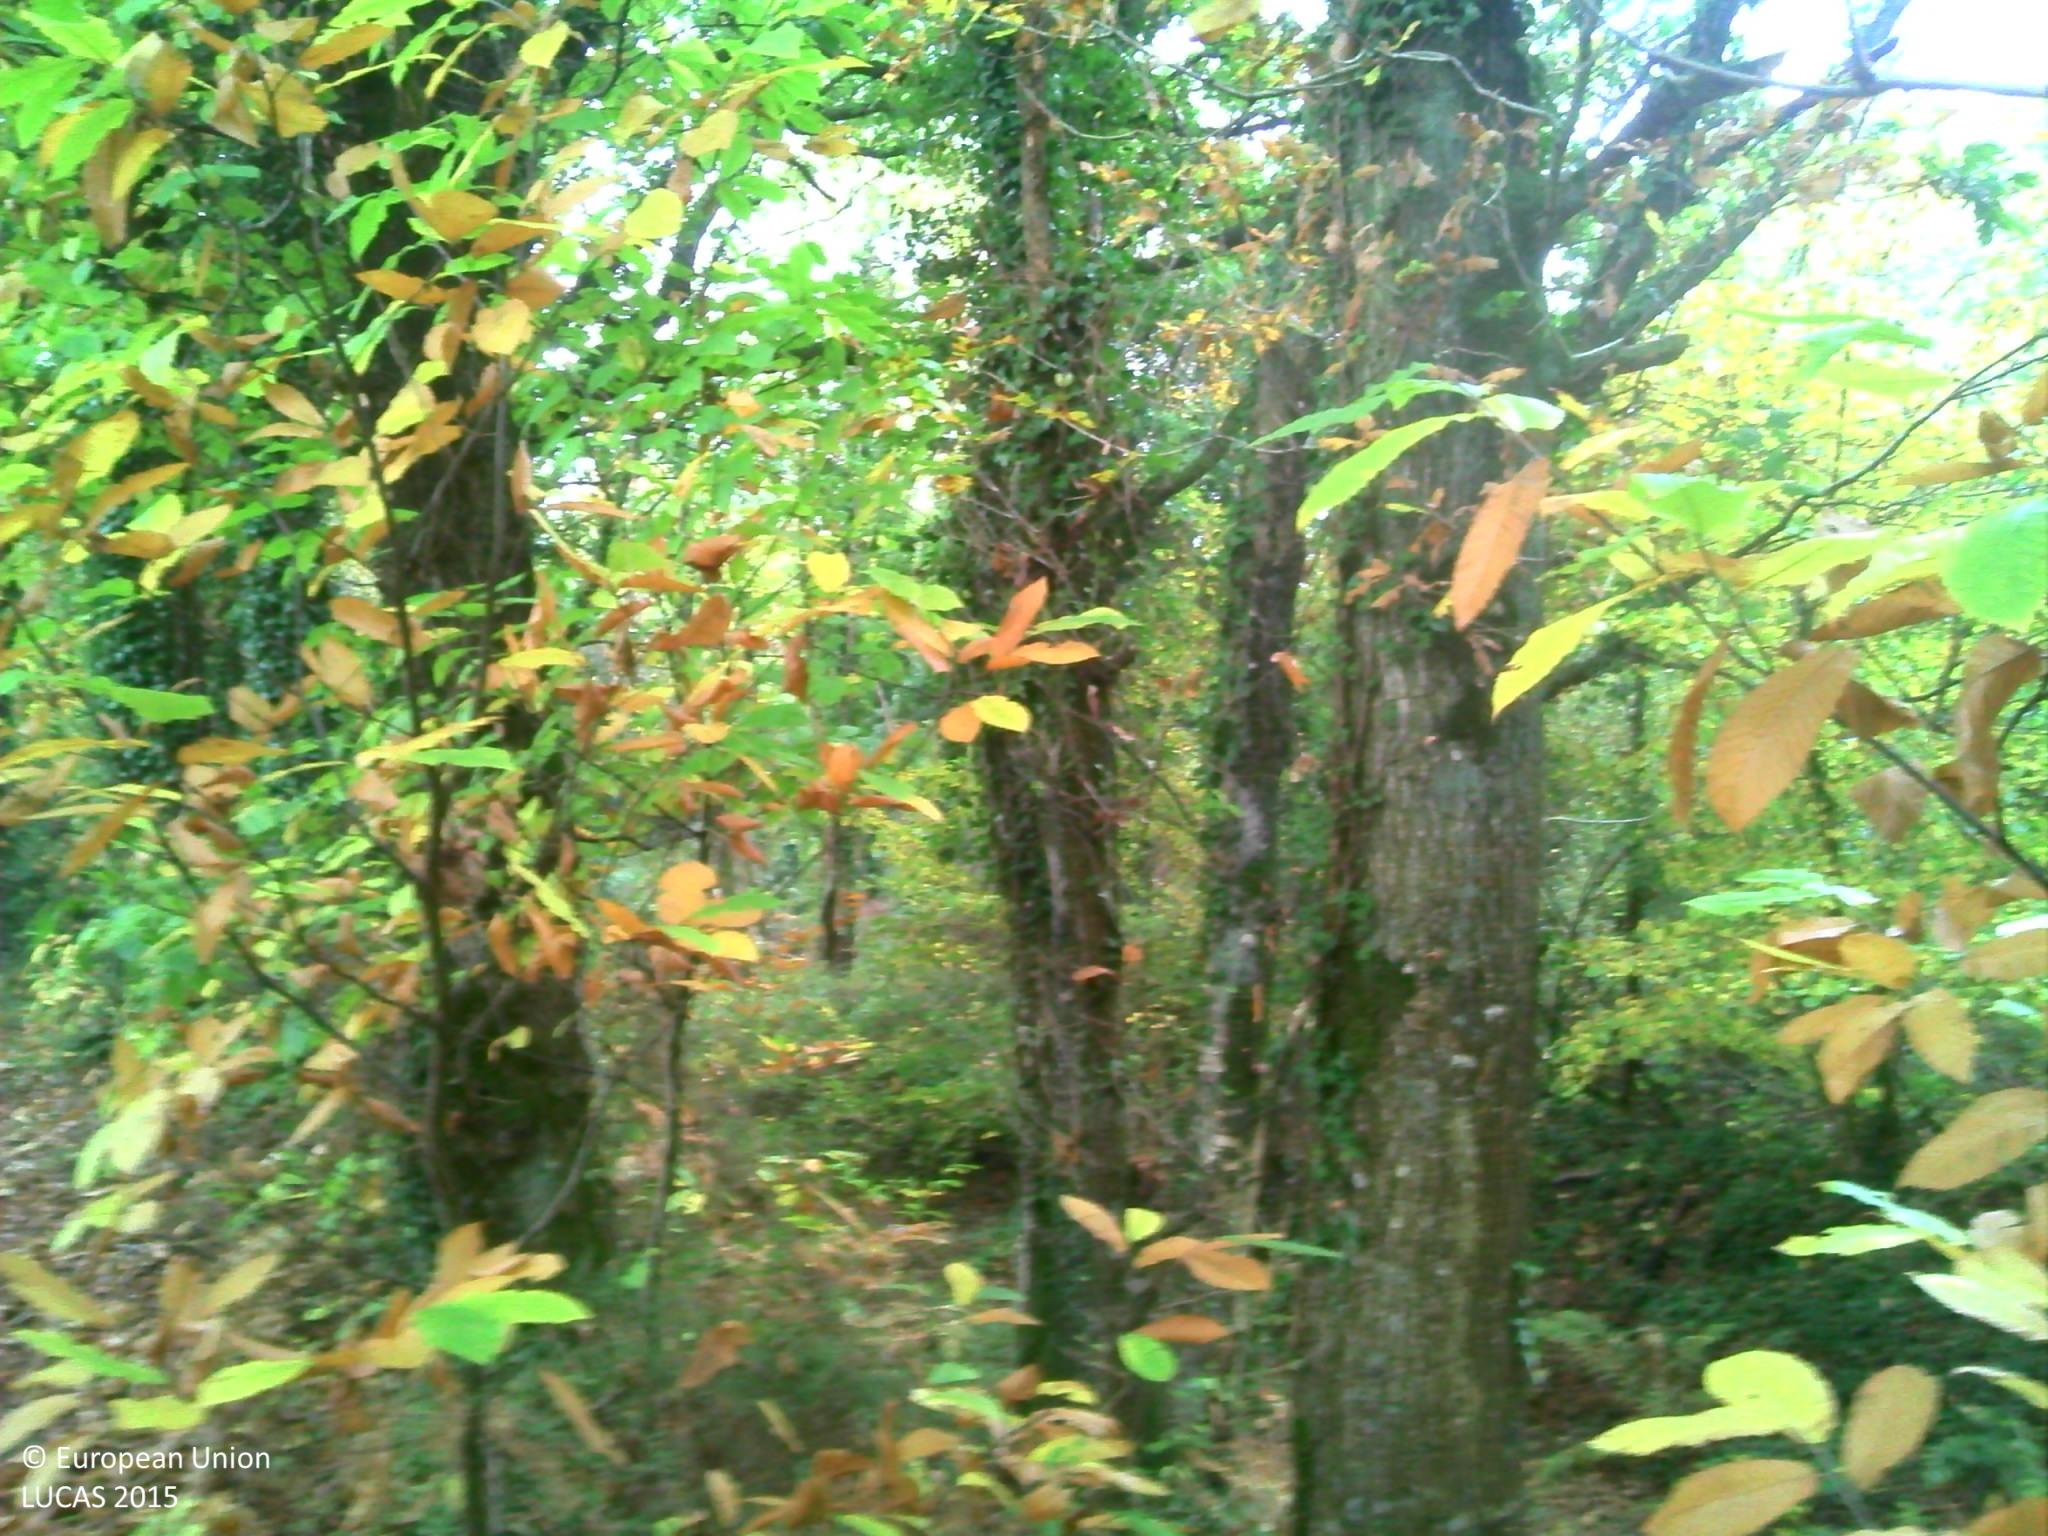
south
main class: Woodland
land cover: Broadleaved woodland
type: acidophilous oak and oak-birch forest
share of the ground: > 75 %
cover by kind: broadleaved forest trees 100 %
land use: Forestry
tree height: > 5 m
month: November
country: FR
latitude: 48.1234
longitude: -3.0059
